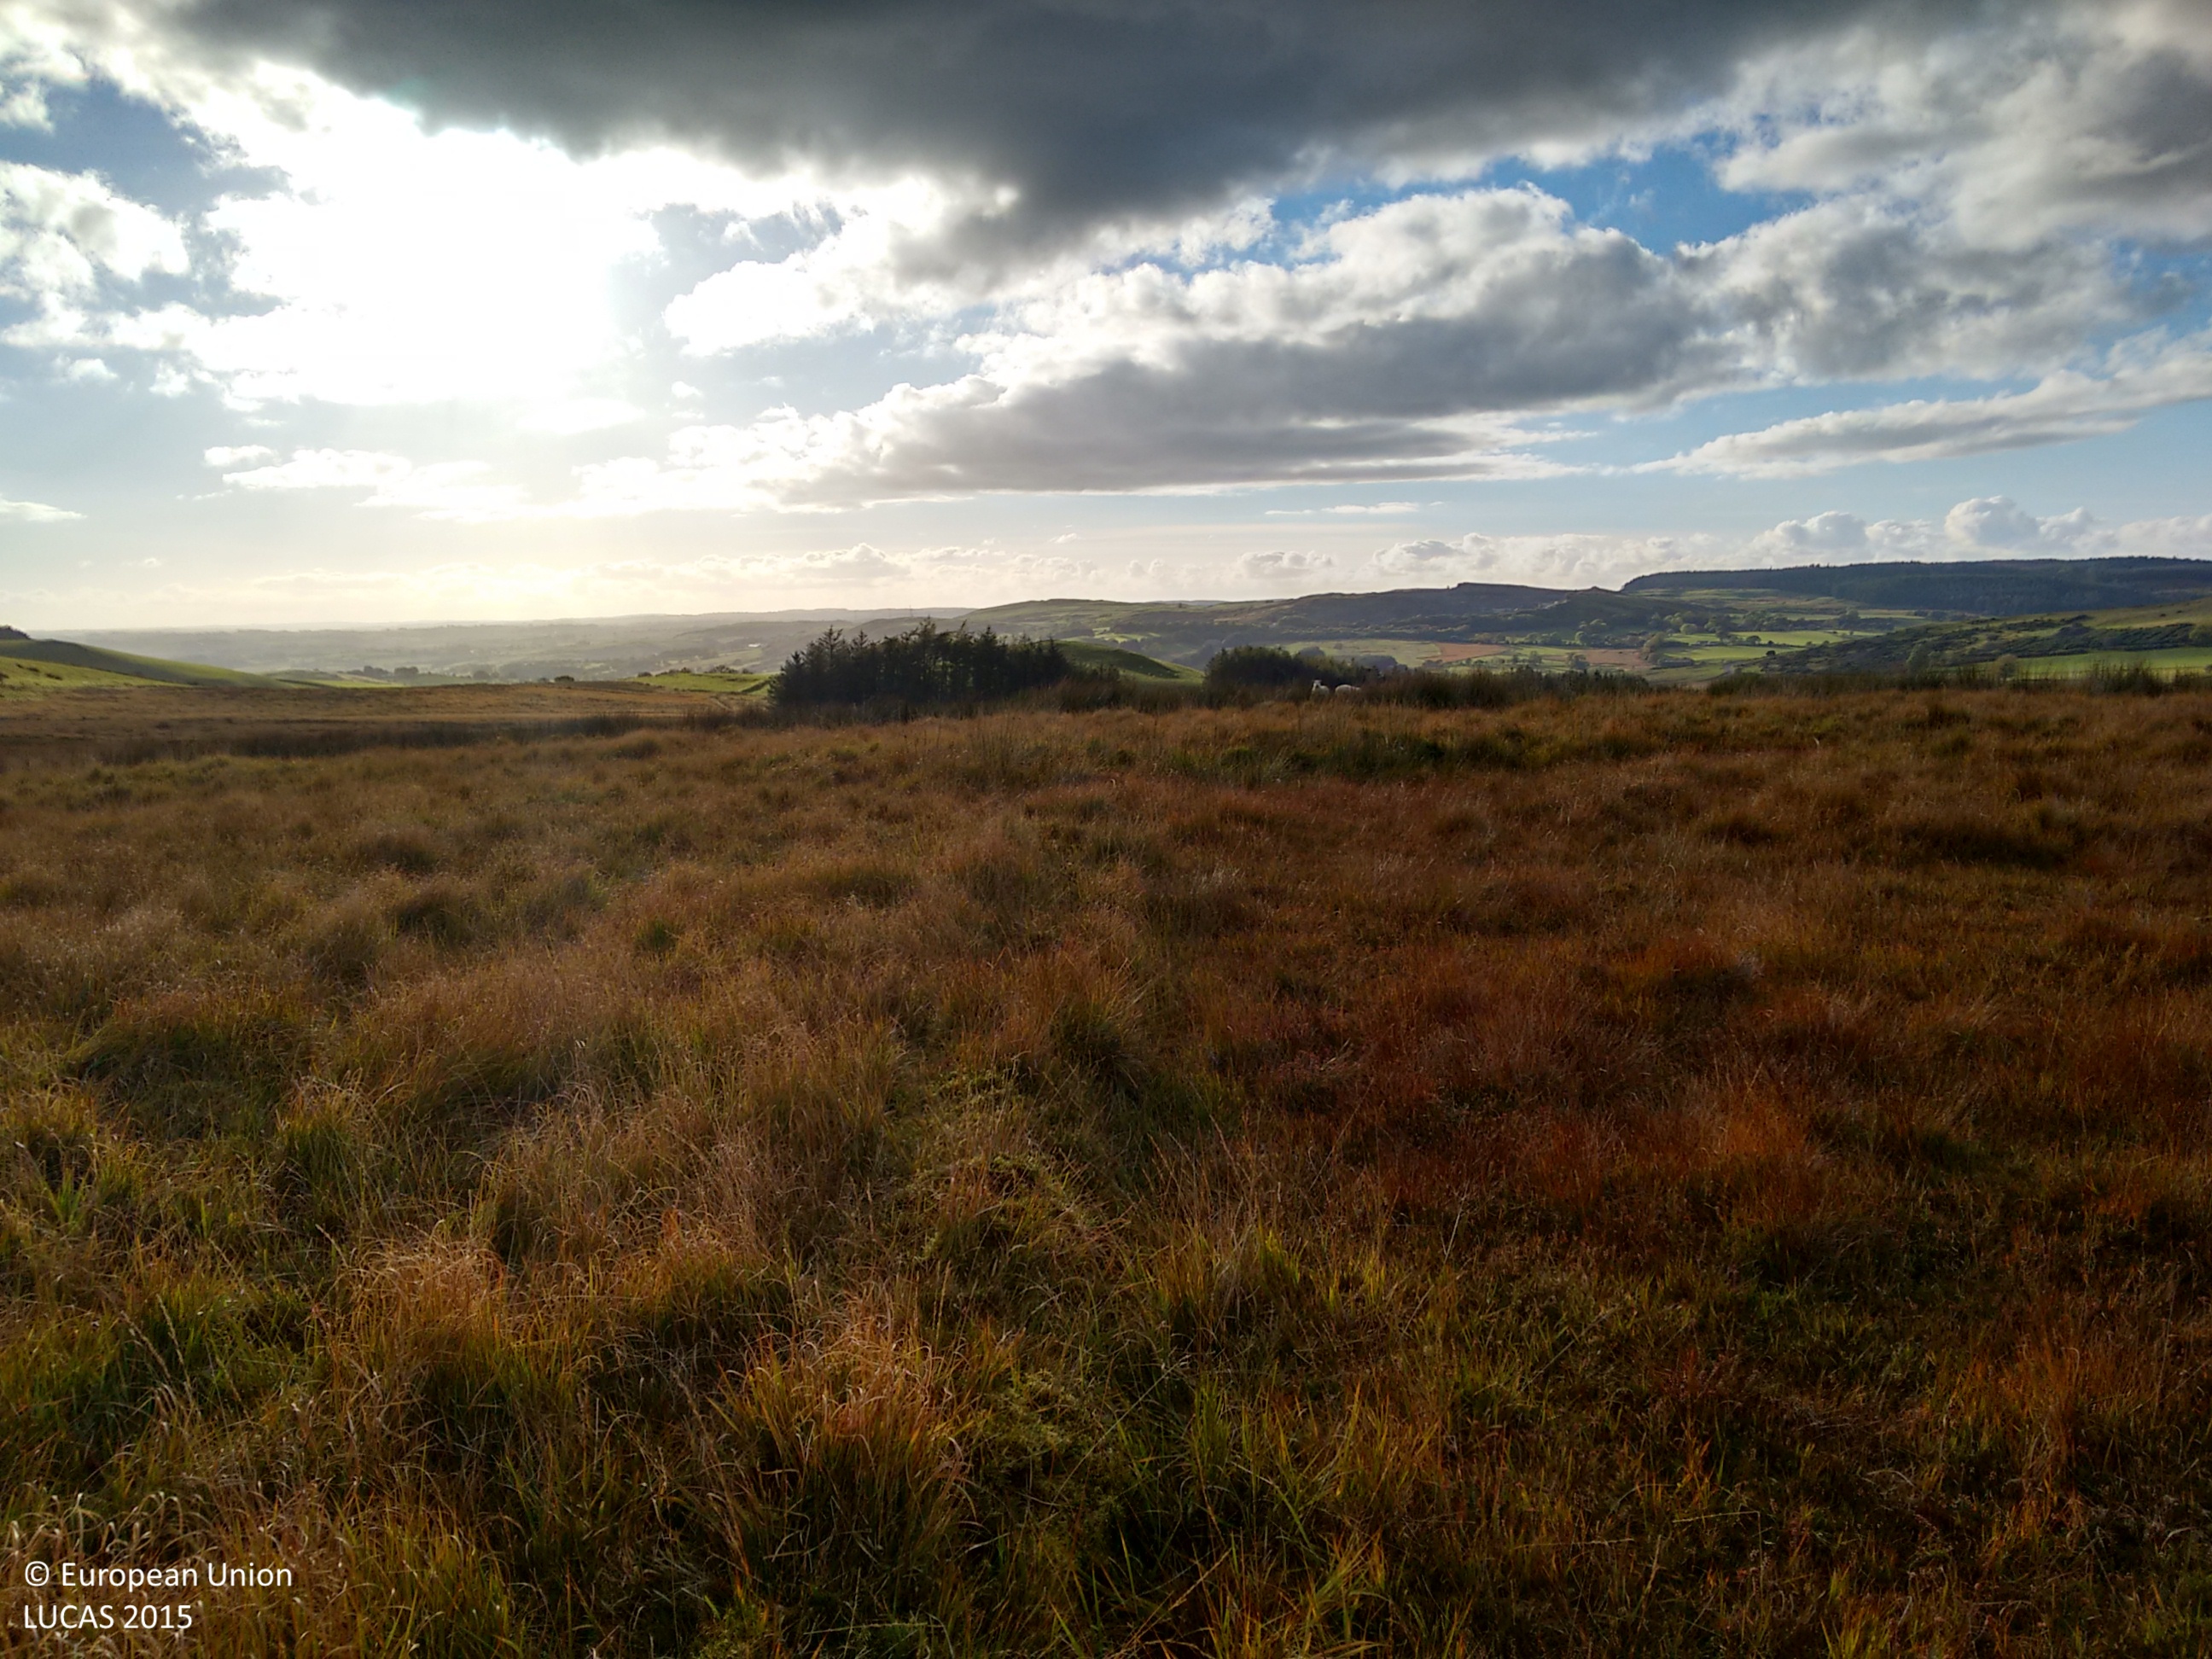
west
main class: Grassland
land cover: Grassland without tree/shrub cover
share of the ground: > 75 %
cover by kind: herbaceous plants 90 %, lichens and mosses 10 %
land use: Agriculture (excluding fallow land and kitchen gardens)
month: October
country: GB
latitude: 52.3105
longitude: -3.8348
